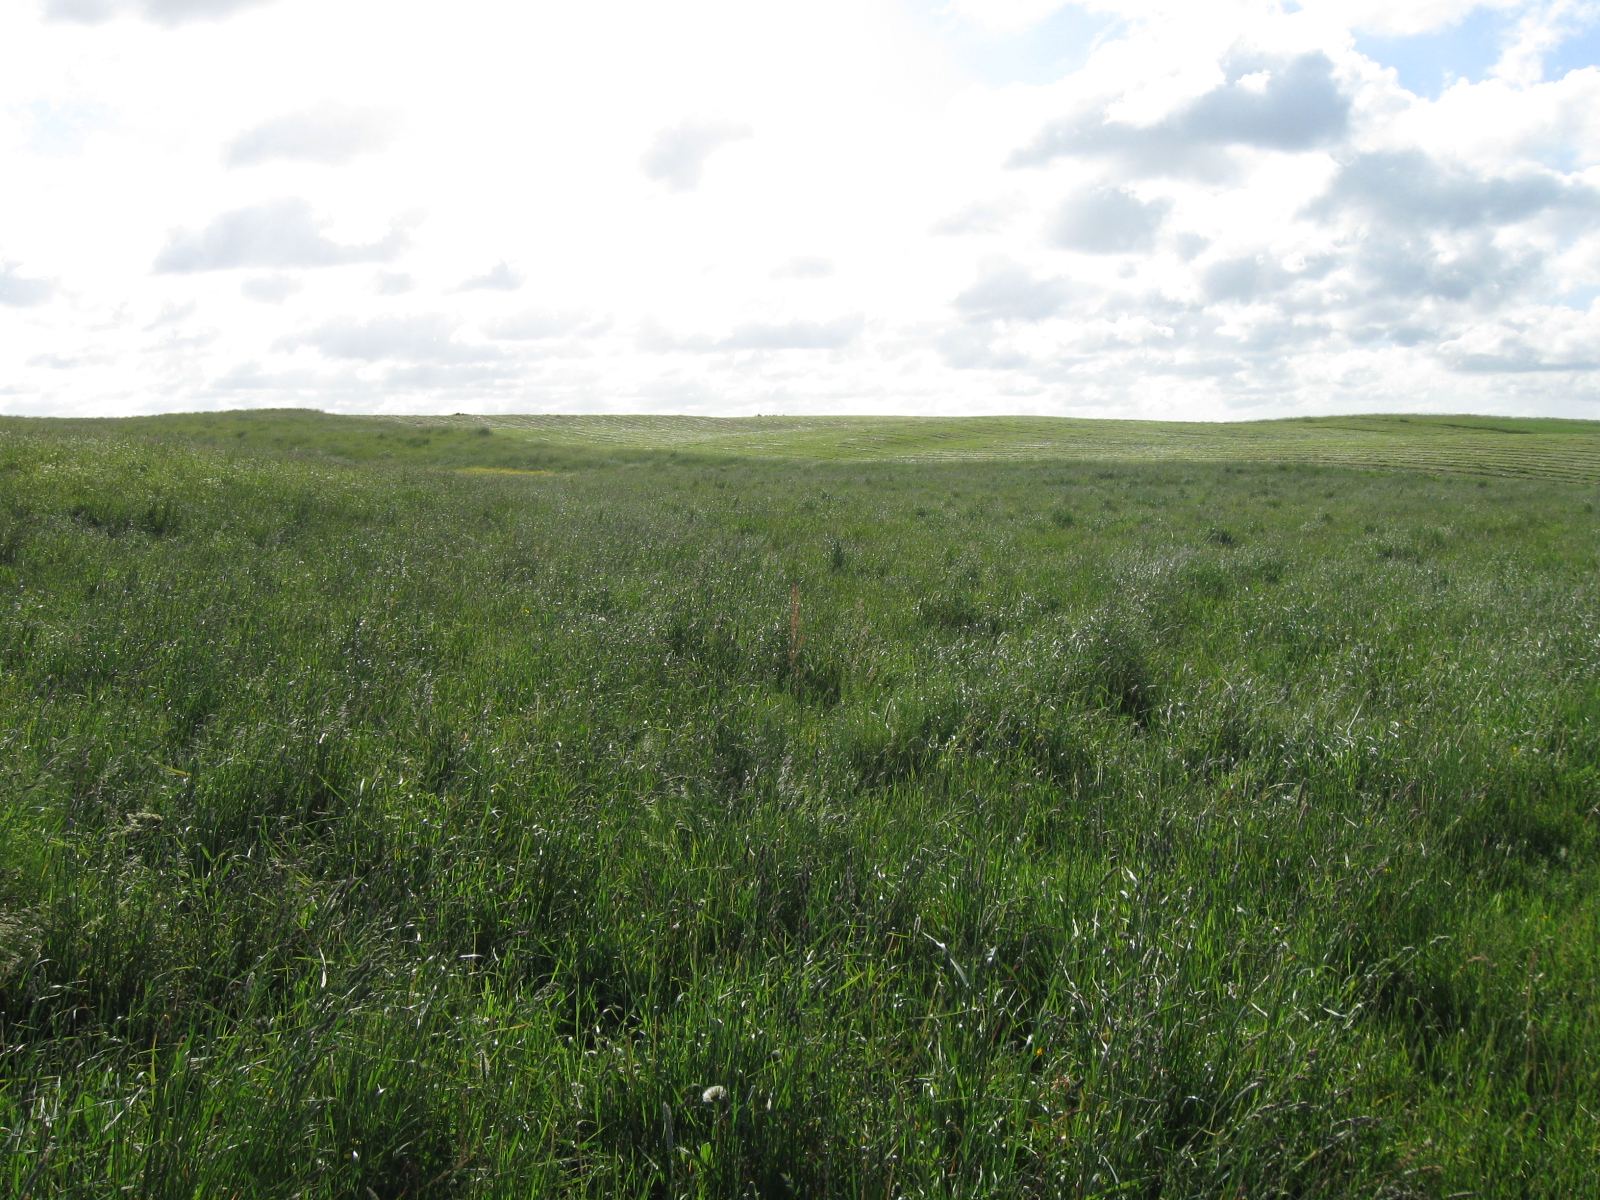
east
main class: Grassland
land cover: Grassland without tree/shrub cover
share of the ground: > 75 %
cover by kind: herbaceous plants 100 %
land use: Agriculture (excluding fallow land and kitchen gardens)
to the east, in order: Grassland without tree/shrub cover
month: June
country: LT
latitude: 54.3668
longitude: 23.8962
